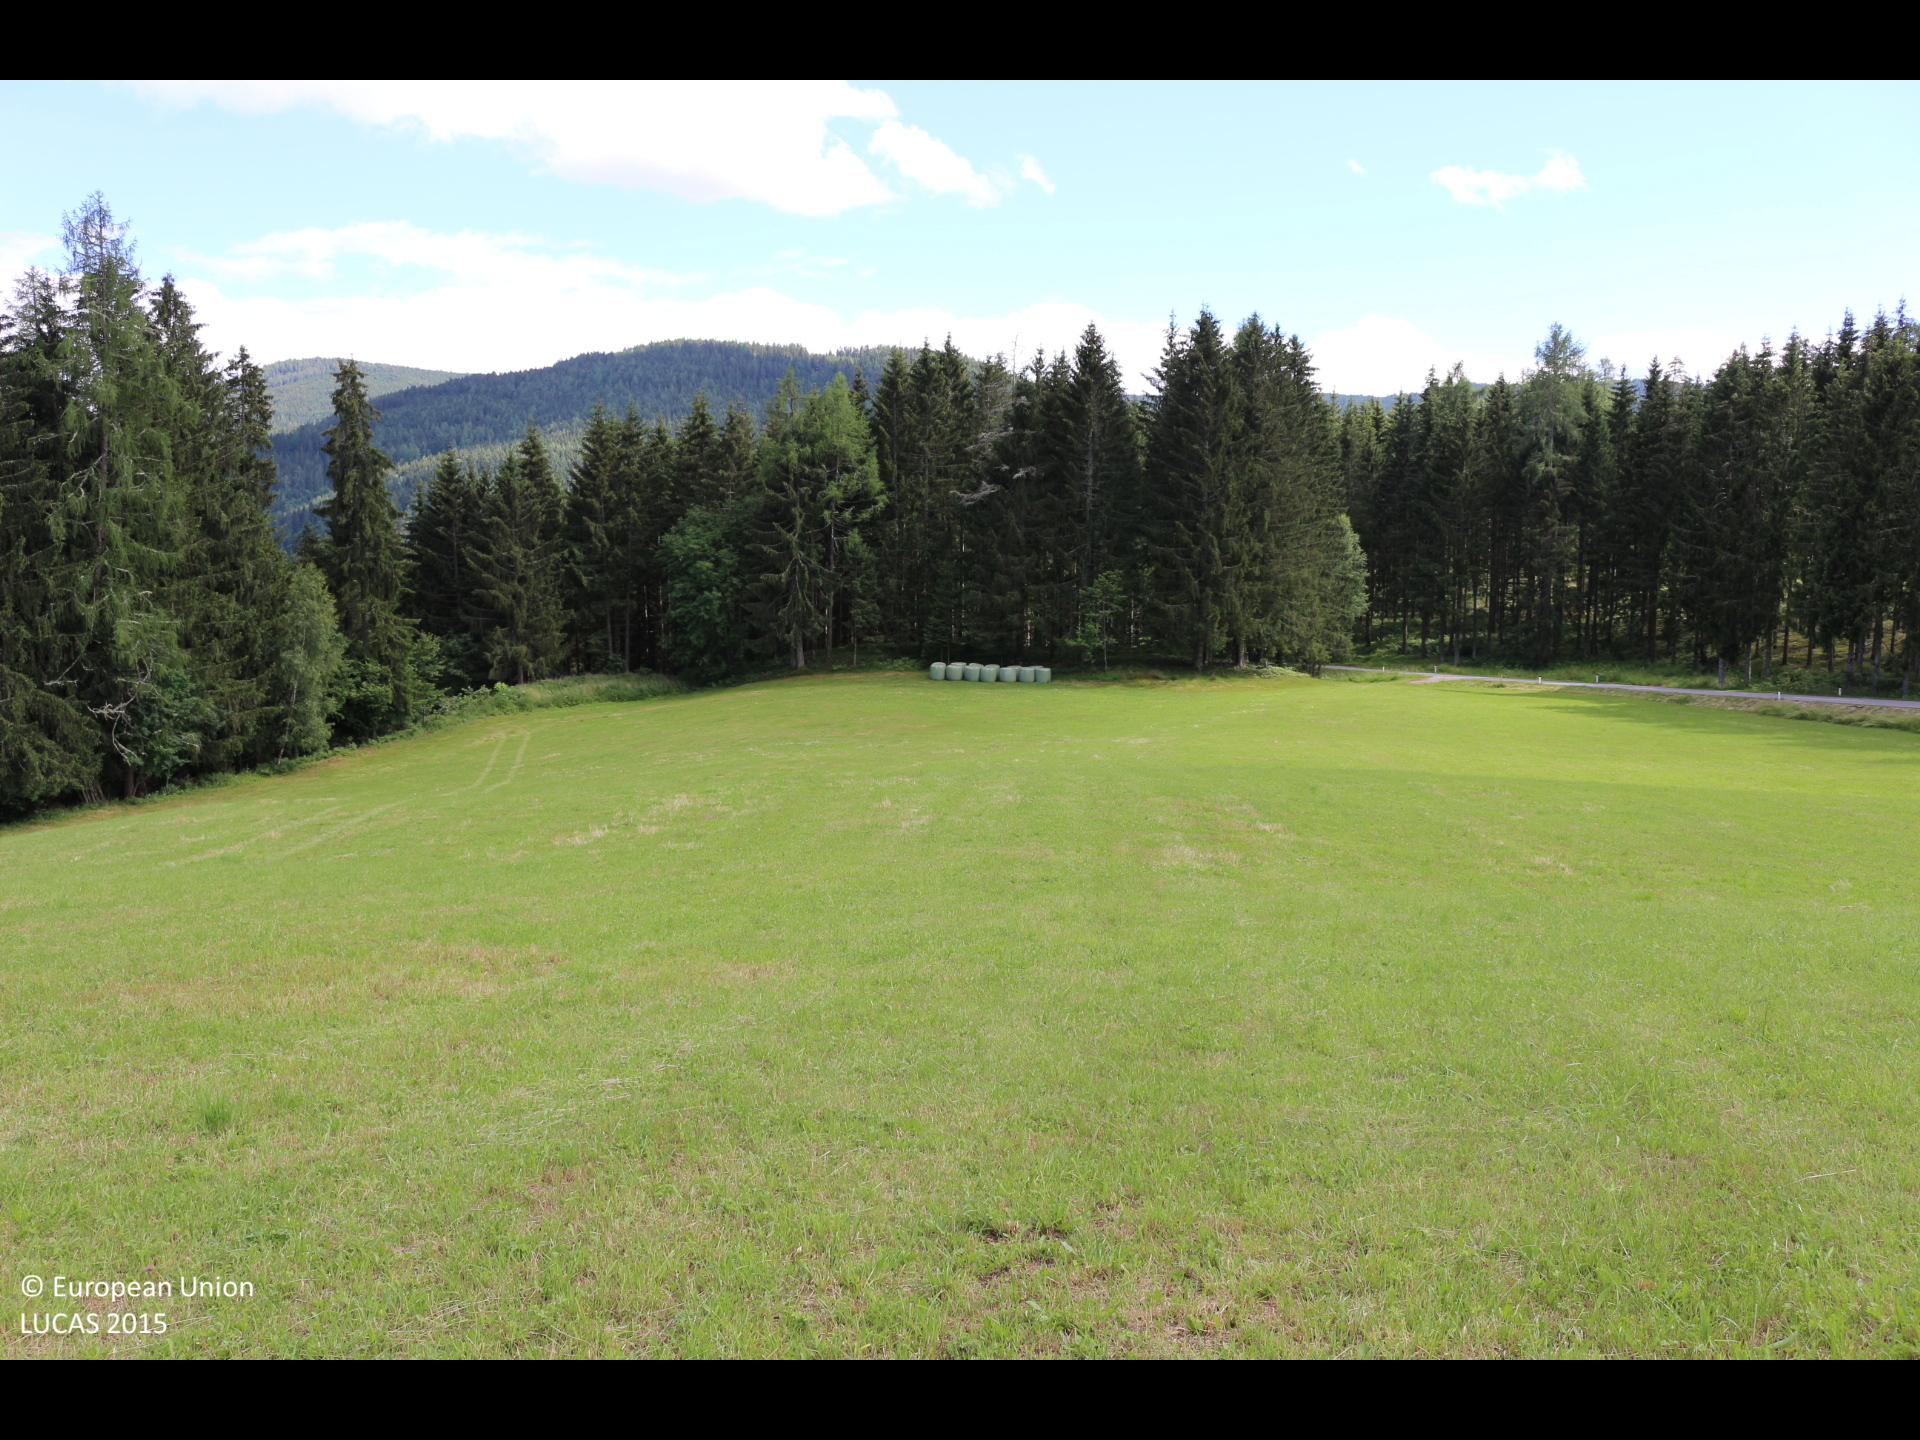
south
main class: Grassland
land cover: Grassland without tree/shrub cover
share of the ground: > 75 %
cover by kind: herbaceous plants 100 %
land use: Agriculture (excluding fallow land and kitchen gardens)
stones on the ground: < 10 %
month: June
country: AT
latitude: 46.8424
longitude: 14.2857
